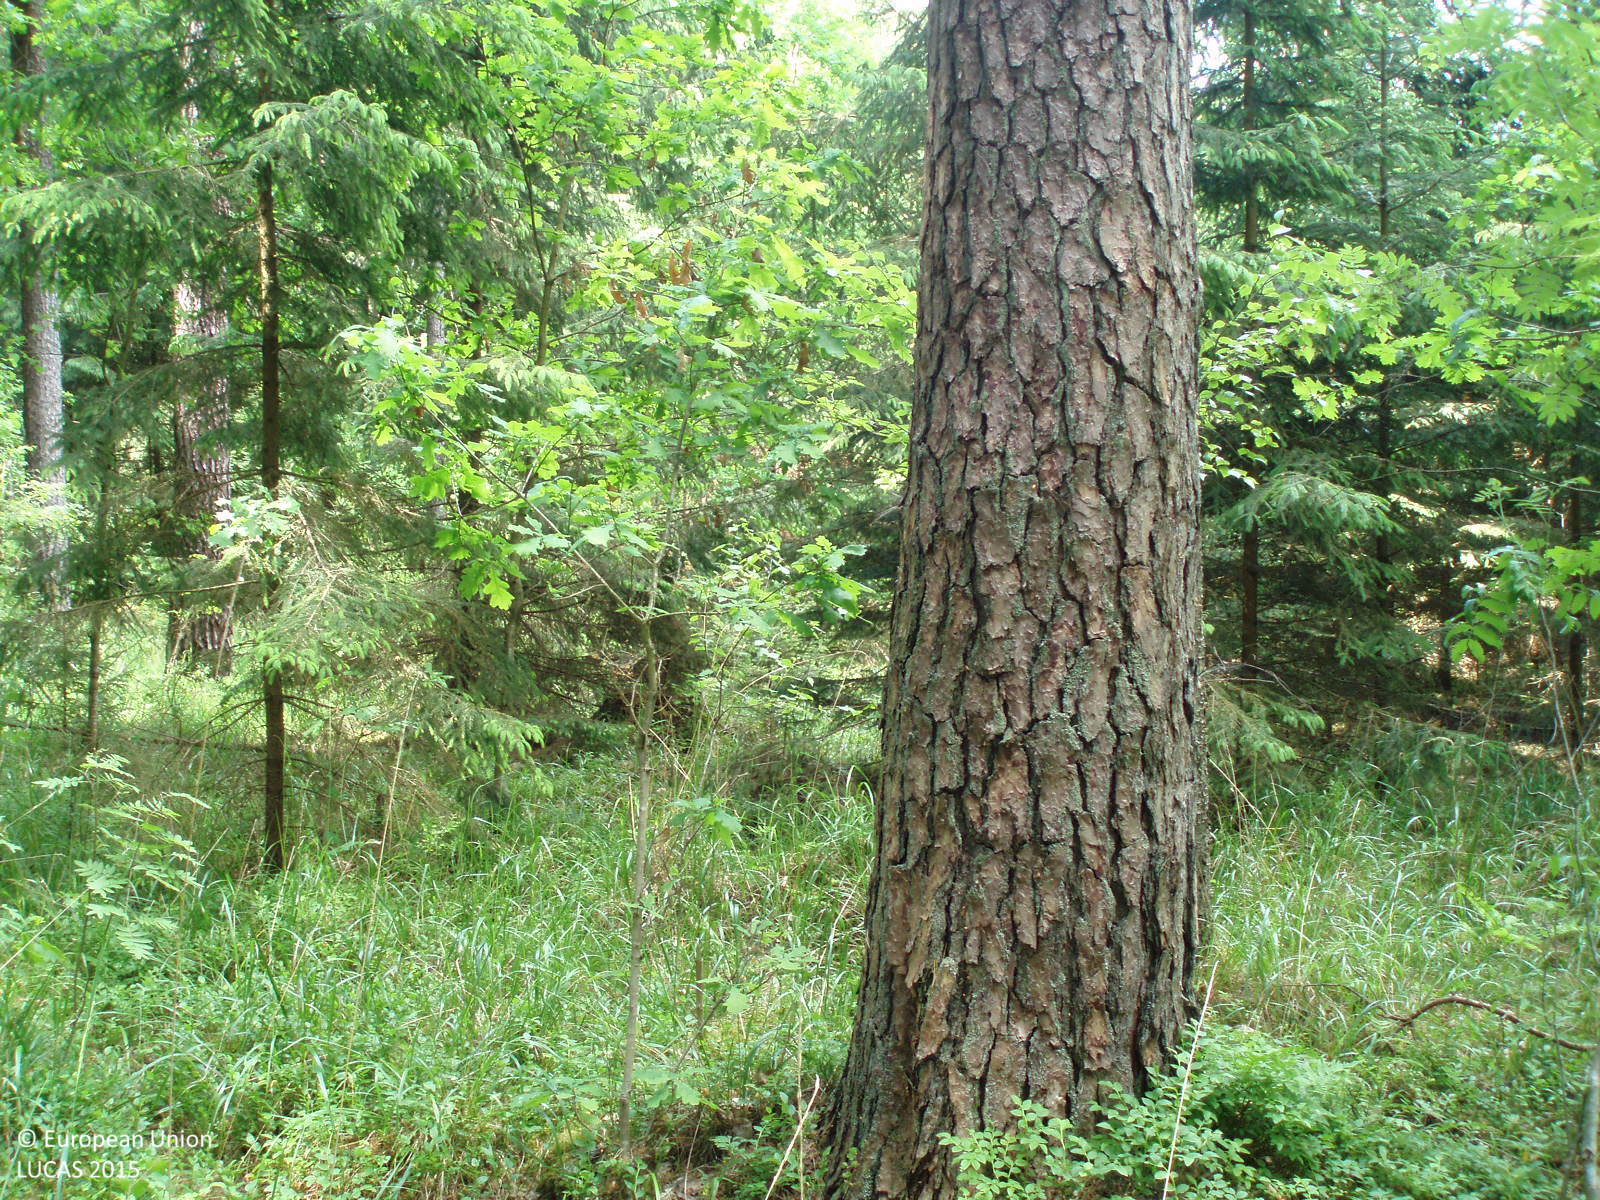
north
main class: Woodland
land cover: Other coniferous woodland
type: hemiboreal forest and nemoral coniferous forest and mixed broadleaved-coniferous forest
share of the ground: > 75 %
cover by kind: coniferous forest trees 70 %, herbaceous plants 20 %, broadleaved forest trees 10 %
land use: Forestry
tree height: > 5 m
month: June
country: LT
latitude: 55.0686
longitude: 22.4484
